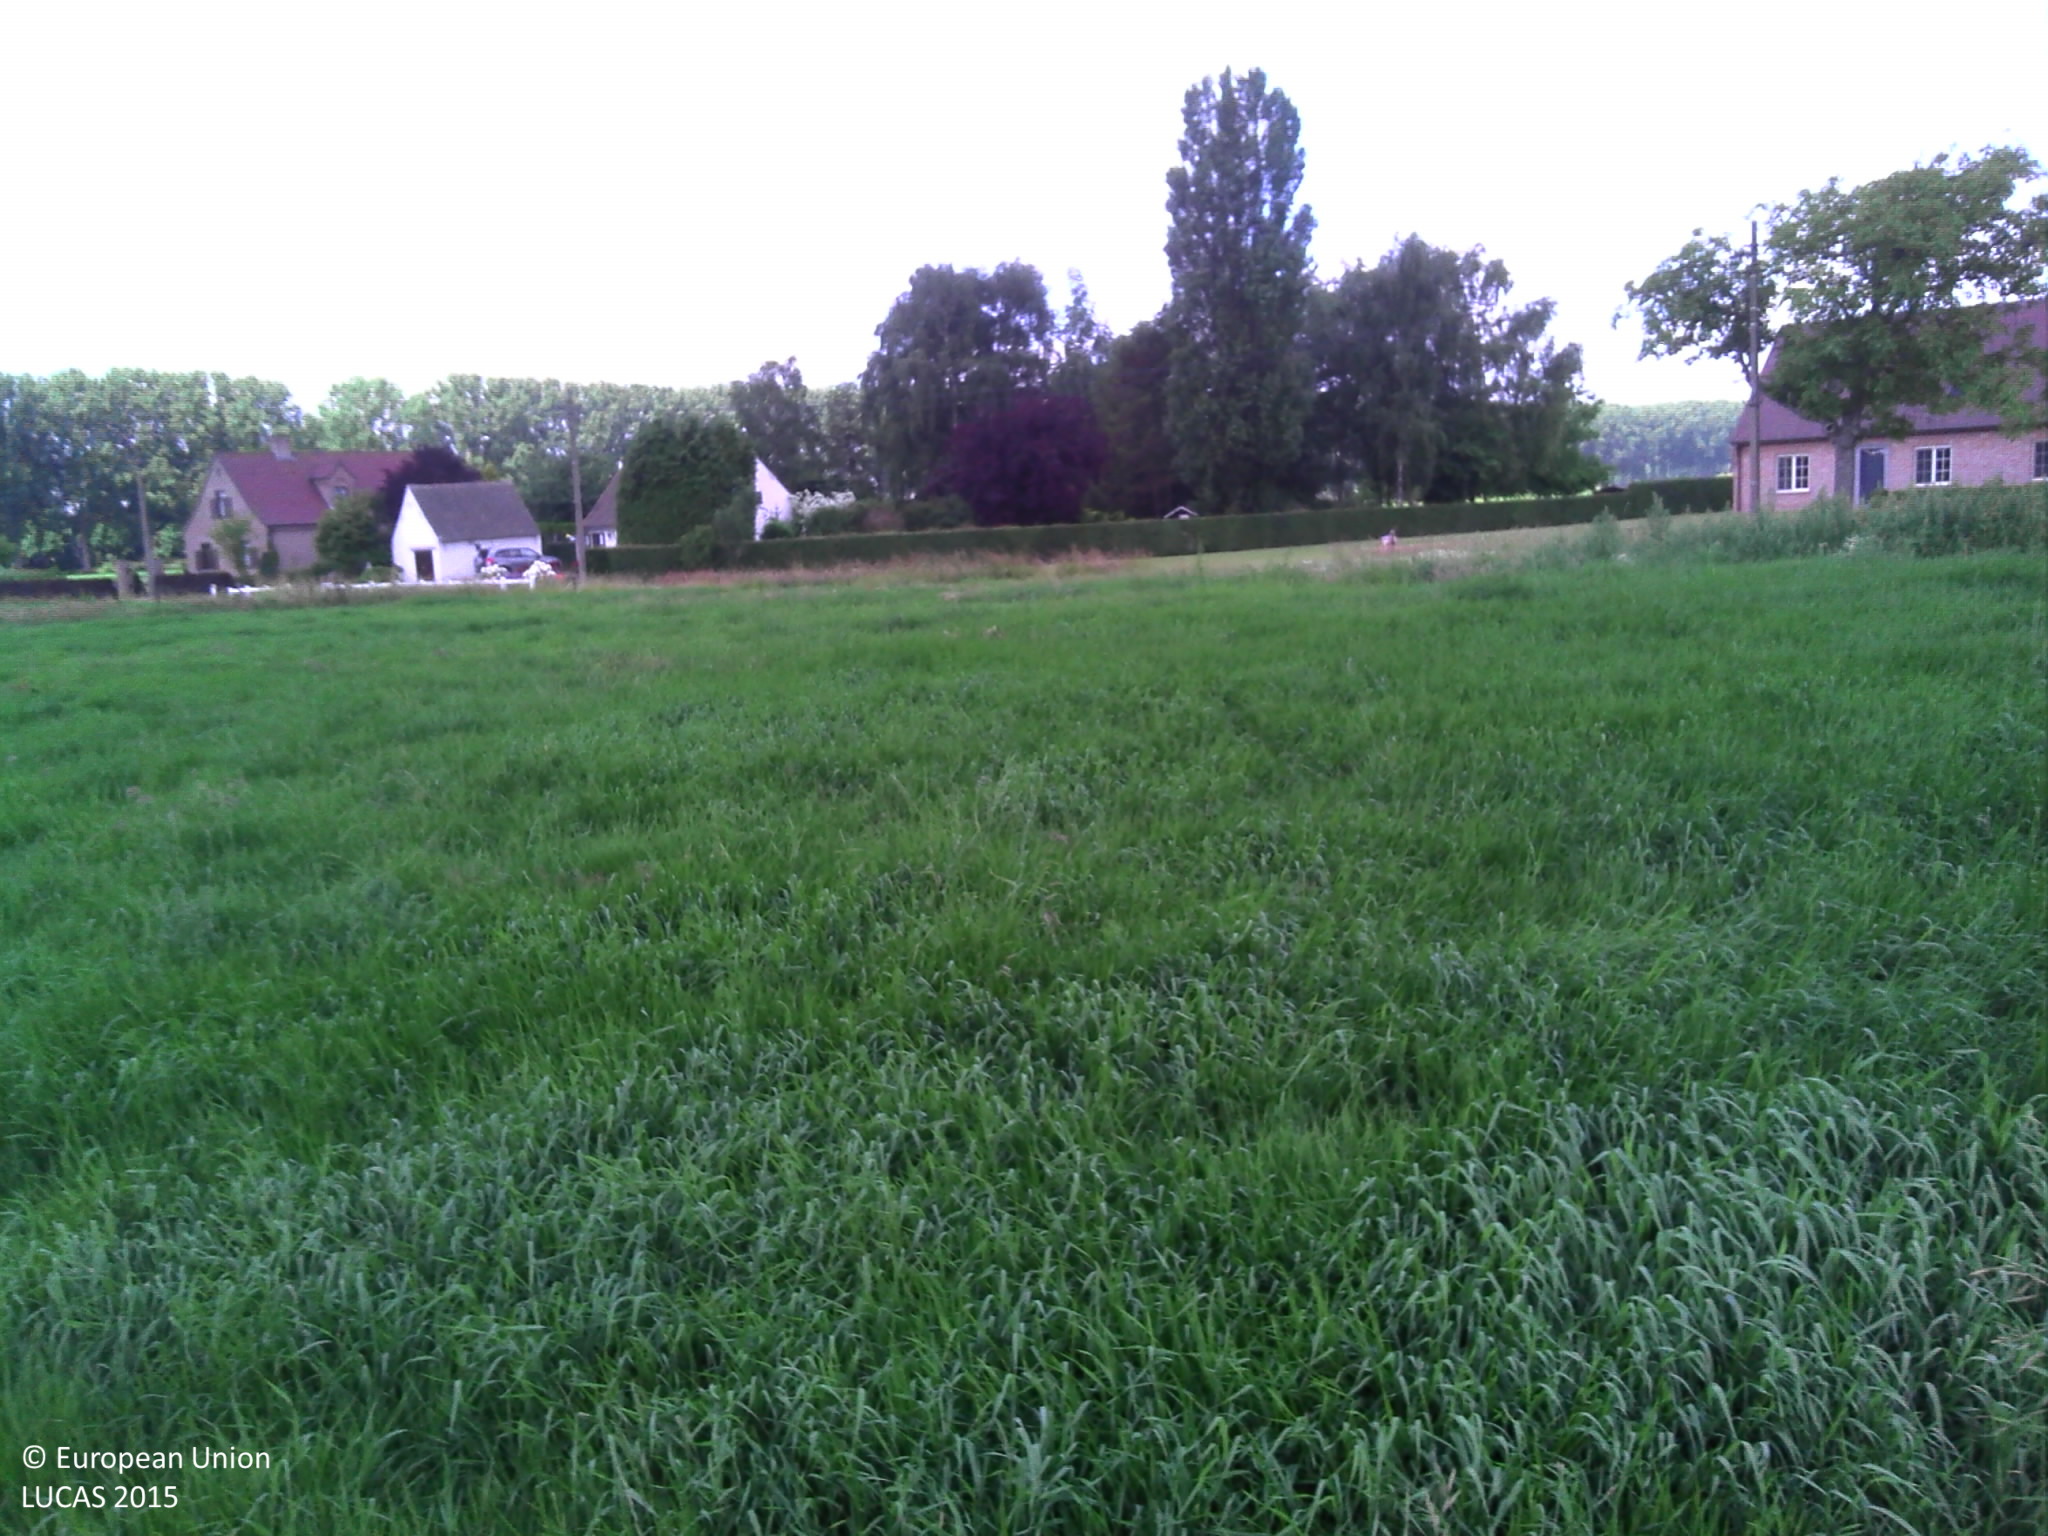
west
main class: Grassland
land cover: Grassland without tree/shrub cover
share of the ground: > 75 %
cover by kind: herbaceous plants 100 %
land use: Agriculture (excluding fallow land and kitchen gardens)
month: June
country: BE
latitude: 51.1215
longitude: 3.5776
